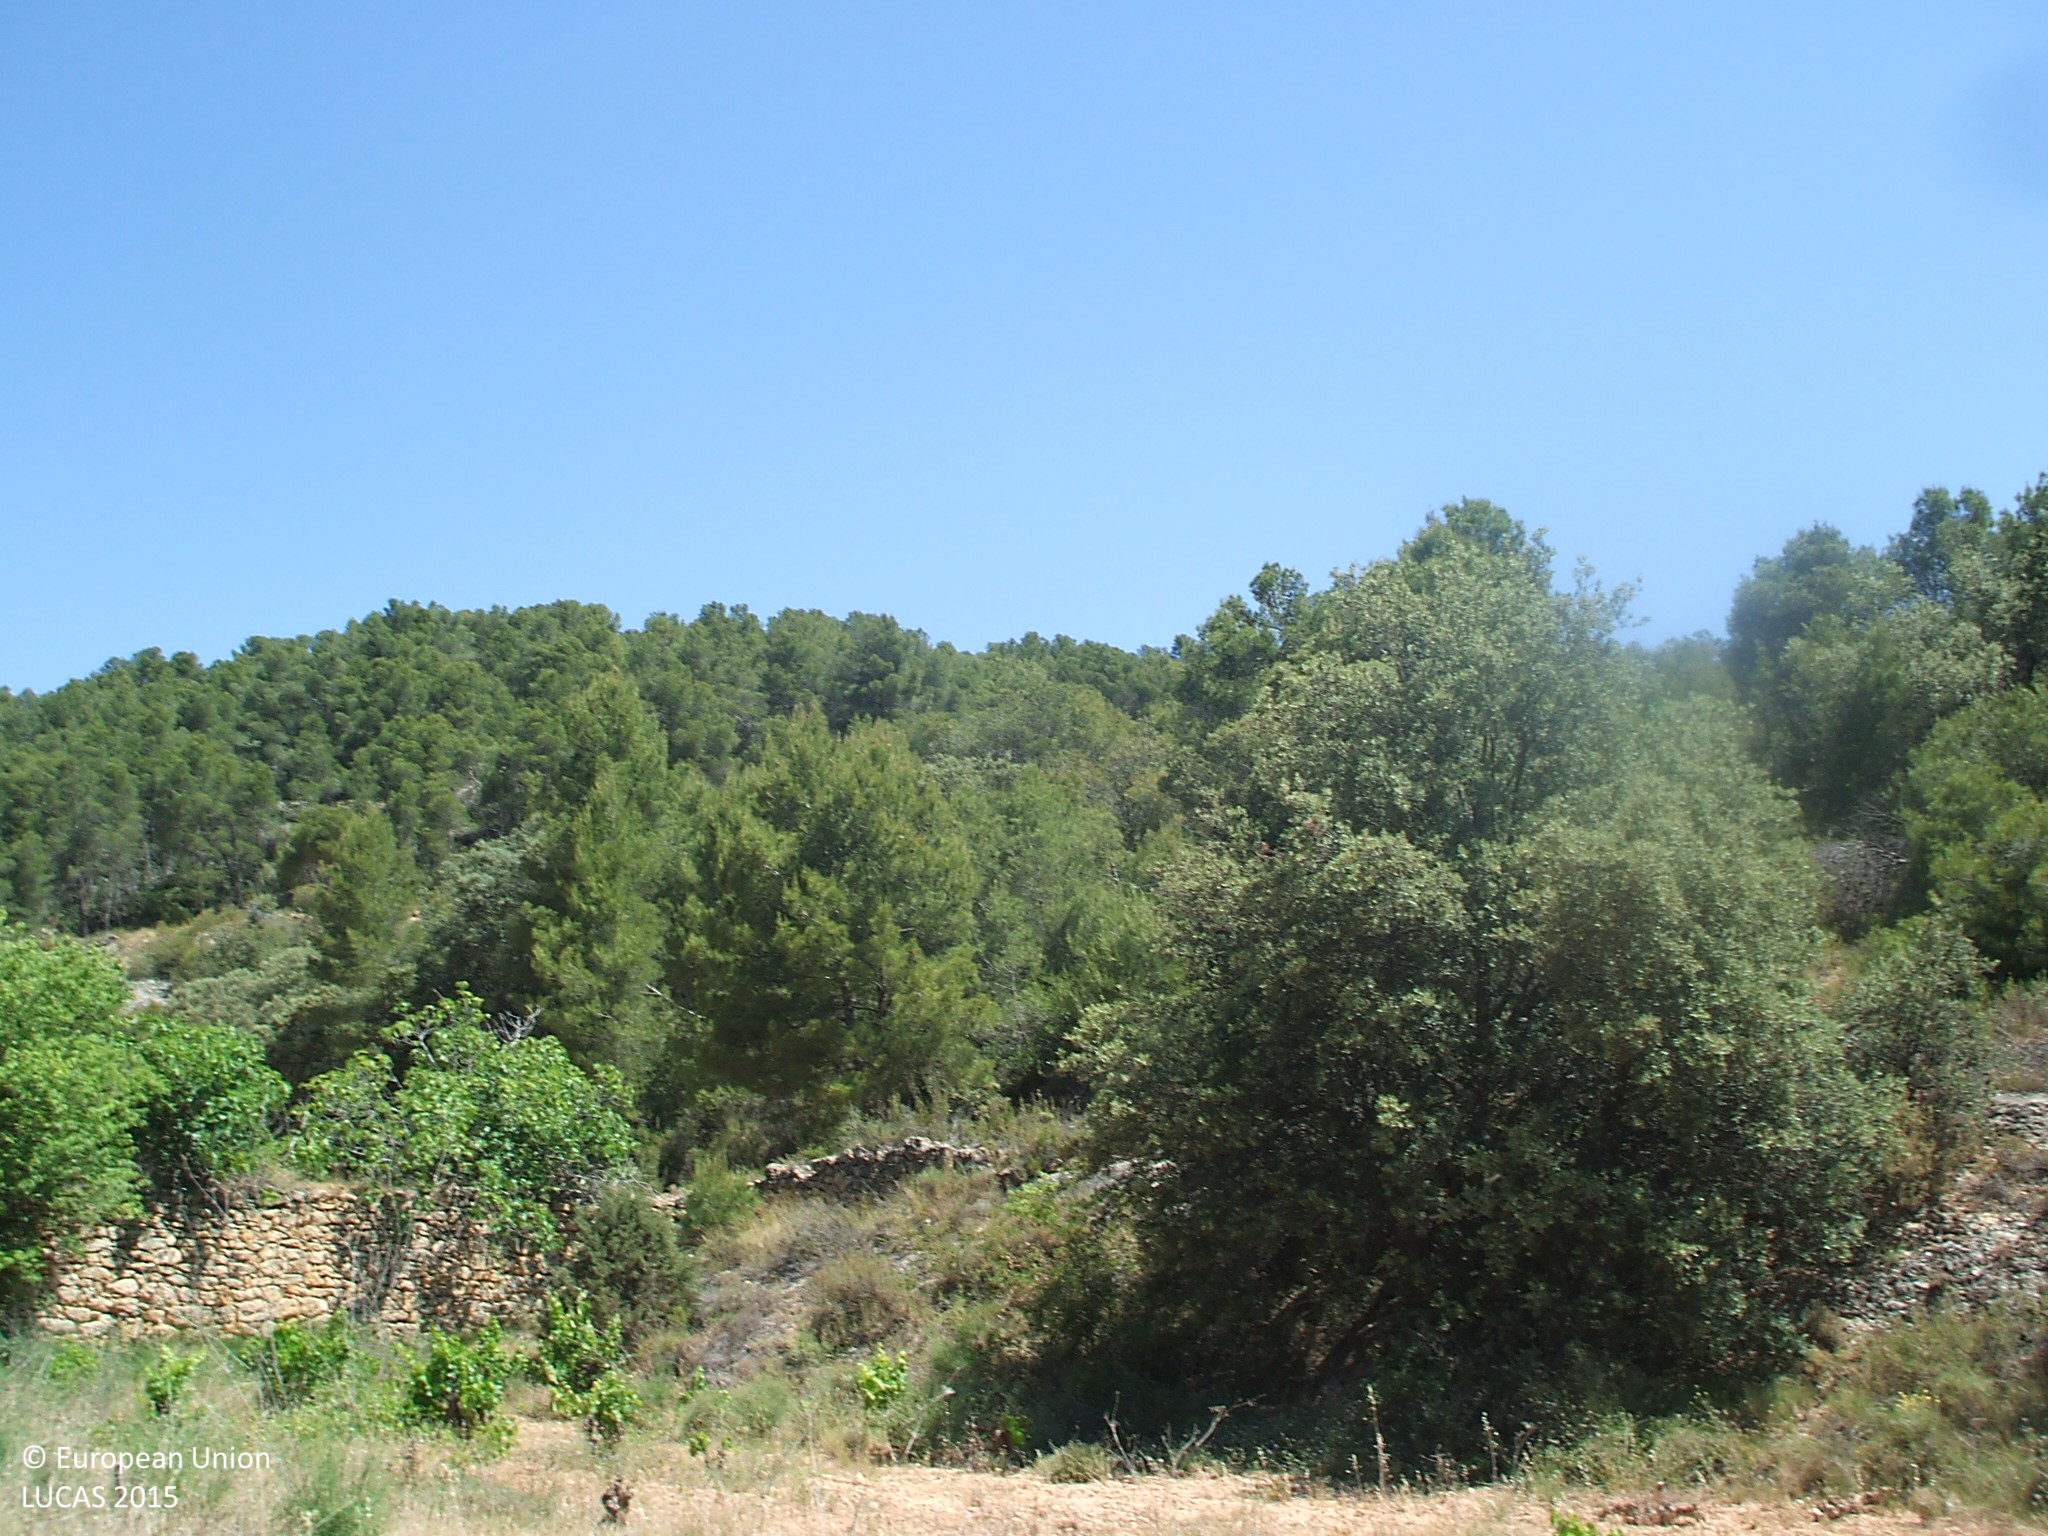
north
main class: Woodland
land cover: Pine dominated mixed woodland
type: coniferous forest of the mediterranean region
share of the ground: 50 - 75 %
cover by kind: shrubs 50 %, coniferous forest trees 25 %, broadleaved forest trees 25 %
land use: Semi-natural and natural areas not in use
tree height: > 5 m
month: June
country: ES
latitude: 40.8471
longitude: -0.0078
